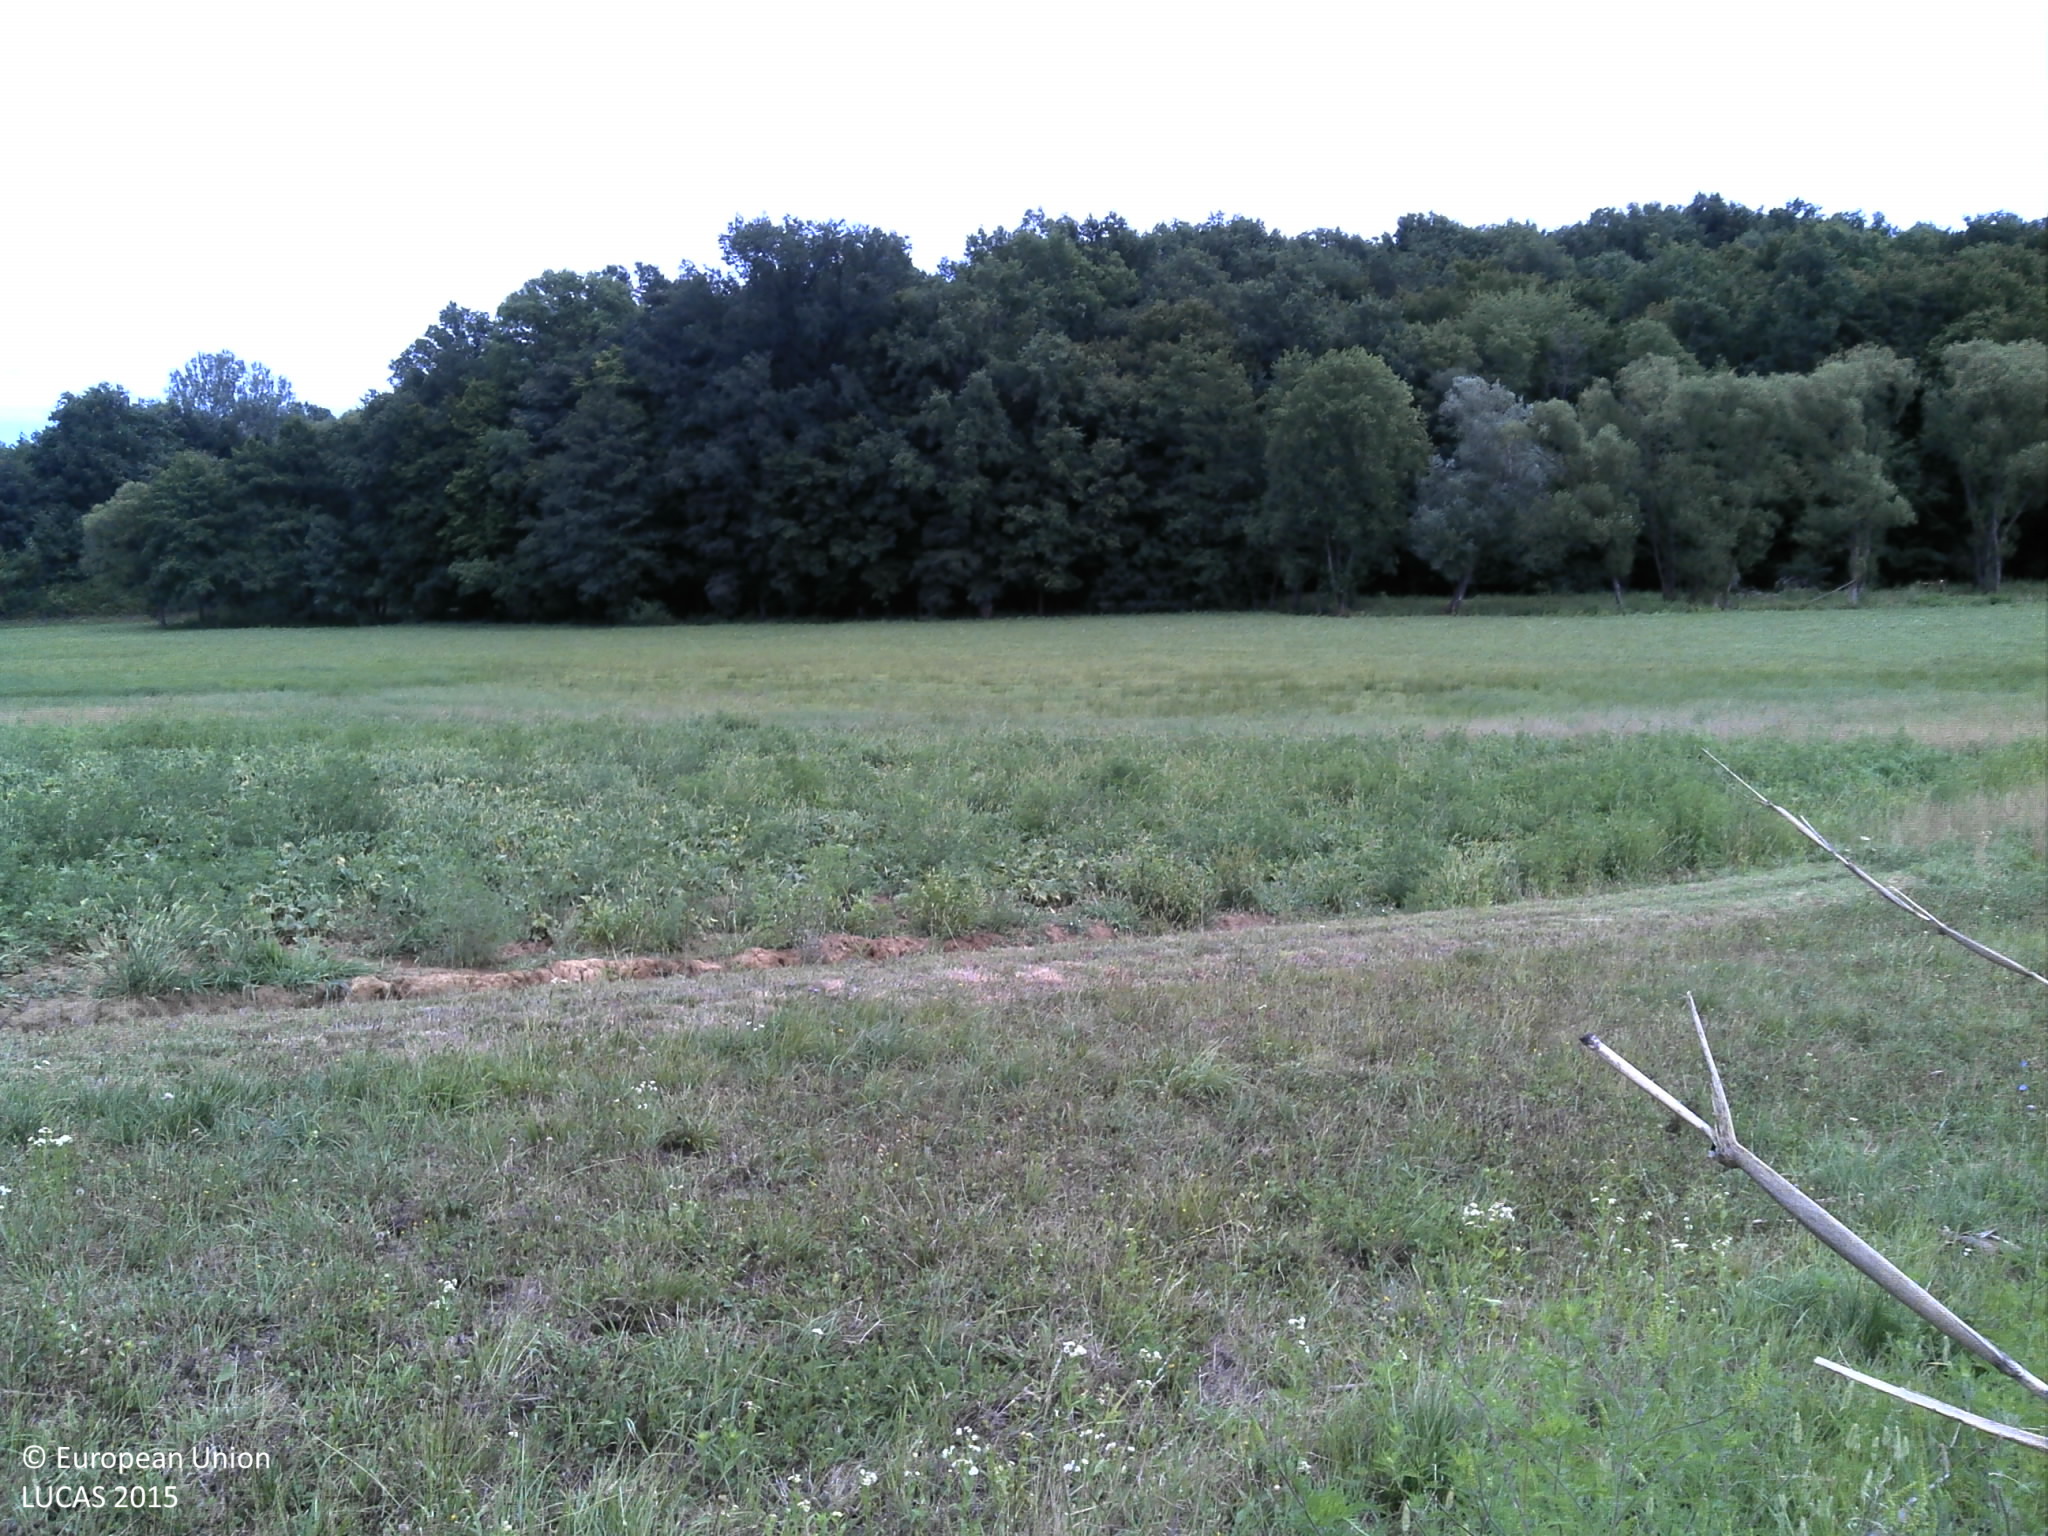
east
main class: Grassland
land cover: Spontaneously vegetated surfaces
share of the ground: > 75 %
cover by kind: herbaceous plants 100 %
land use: Semi-natural and natural areas not in use
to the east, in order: Spontaneously vegetated surfaces; Grassland without tree/shrub cover; Dry pulses; Grassland without tree/shrub cover; Ditches and canals; Broadleaved woodland; Grassland without tree/shrub cover; Shrubland with sparse tree cover
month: July
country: HR
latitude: 45.6034
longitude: 16.6274
